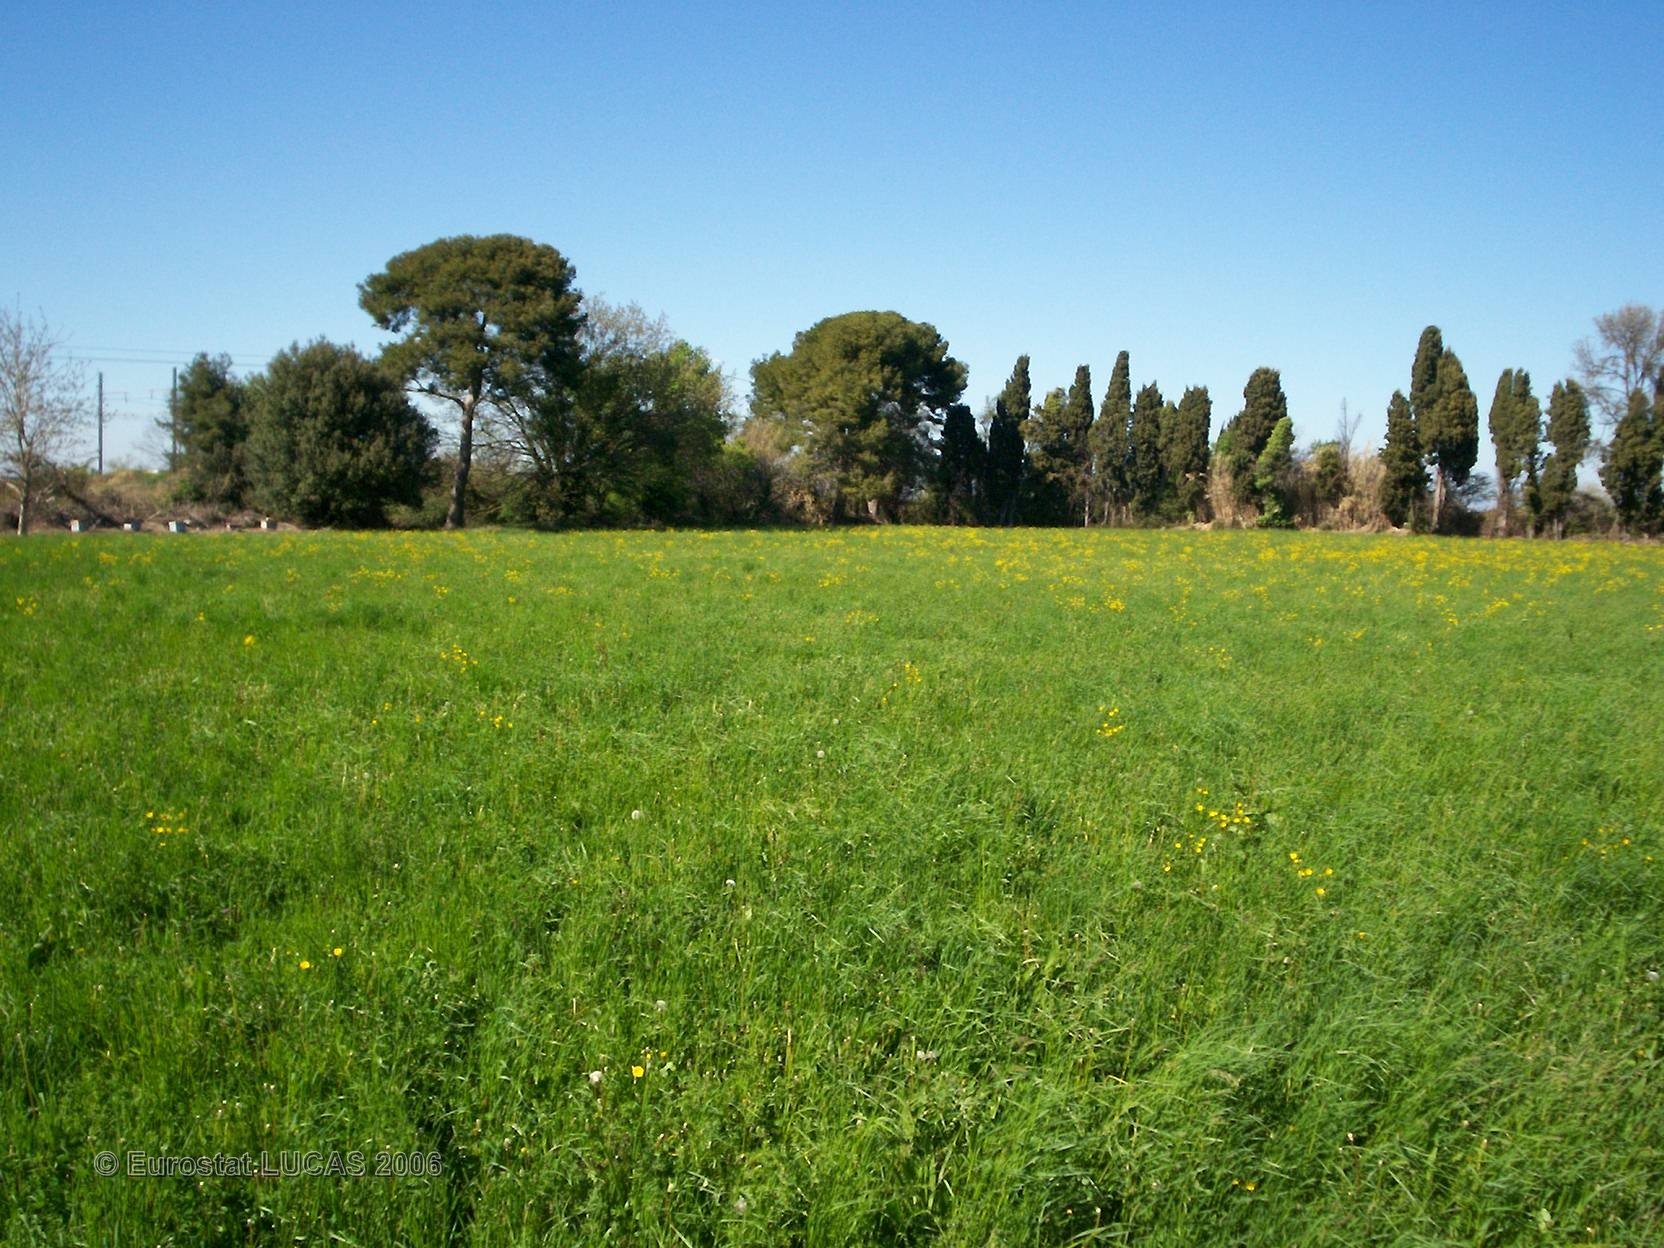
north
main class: Grassland
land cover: Grassland without tree/shrub cover
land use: Agriculture (excluding fallow land and kitchen gardens)
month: April
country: FR
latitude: 43.5600
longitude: 4.9712
